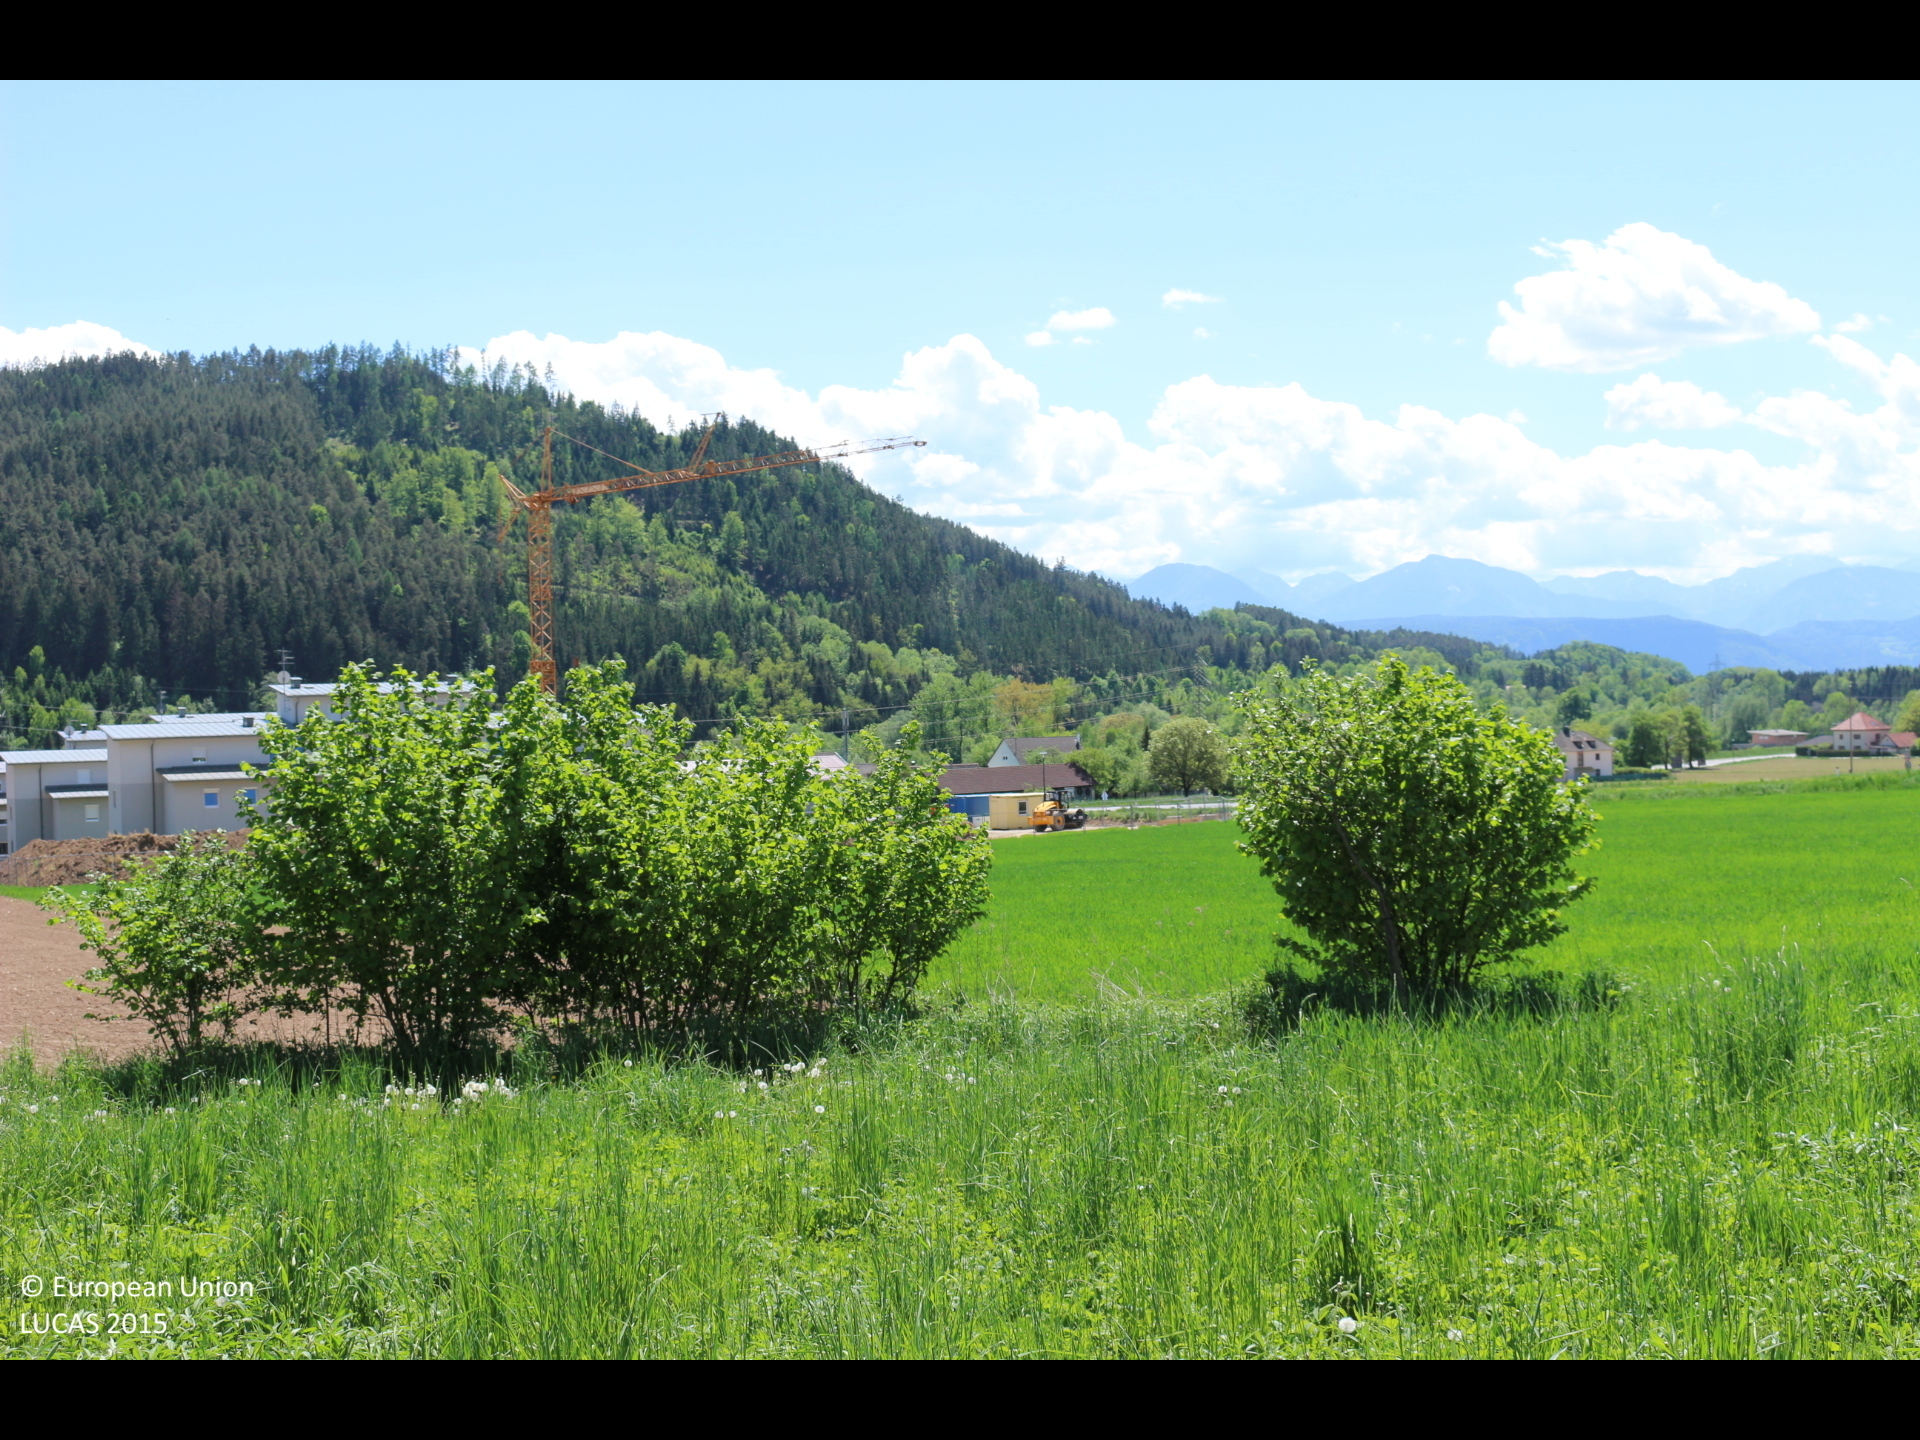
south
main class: Grassland
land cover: Spontaneously vegetated surfaces
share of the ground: > 75 %
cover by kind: herbaceous plants 95 %, shrubs 5 %
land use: Fallow land
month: May
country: AT
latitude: 46.6912
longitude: 14.4566
